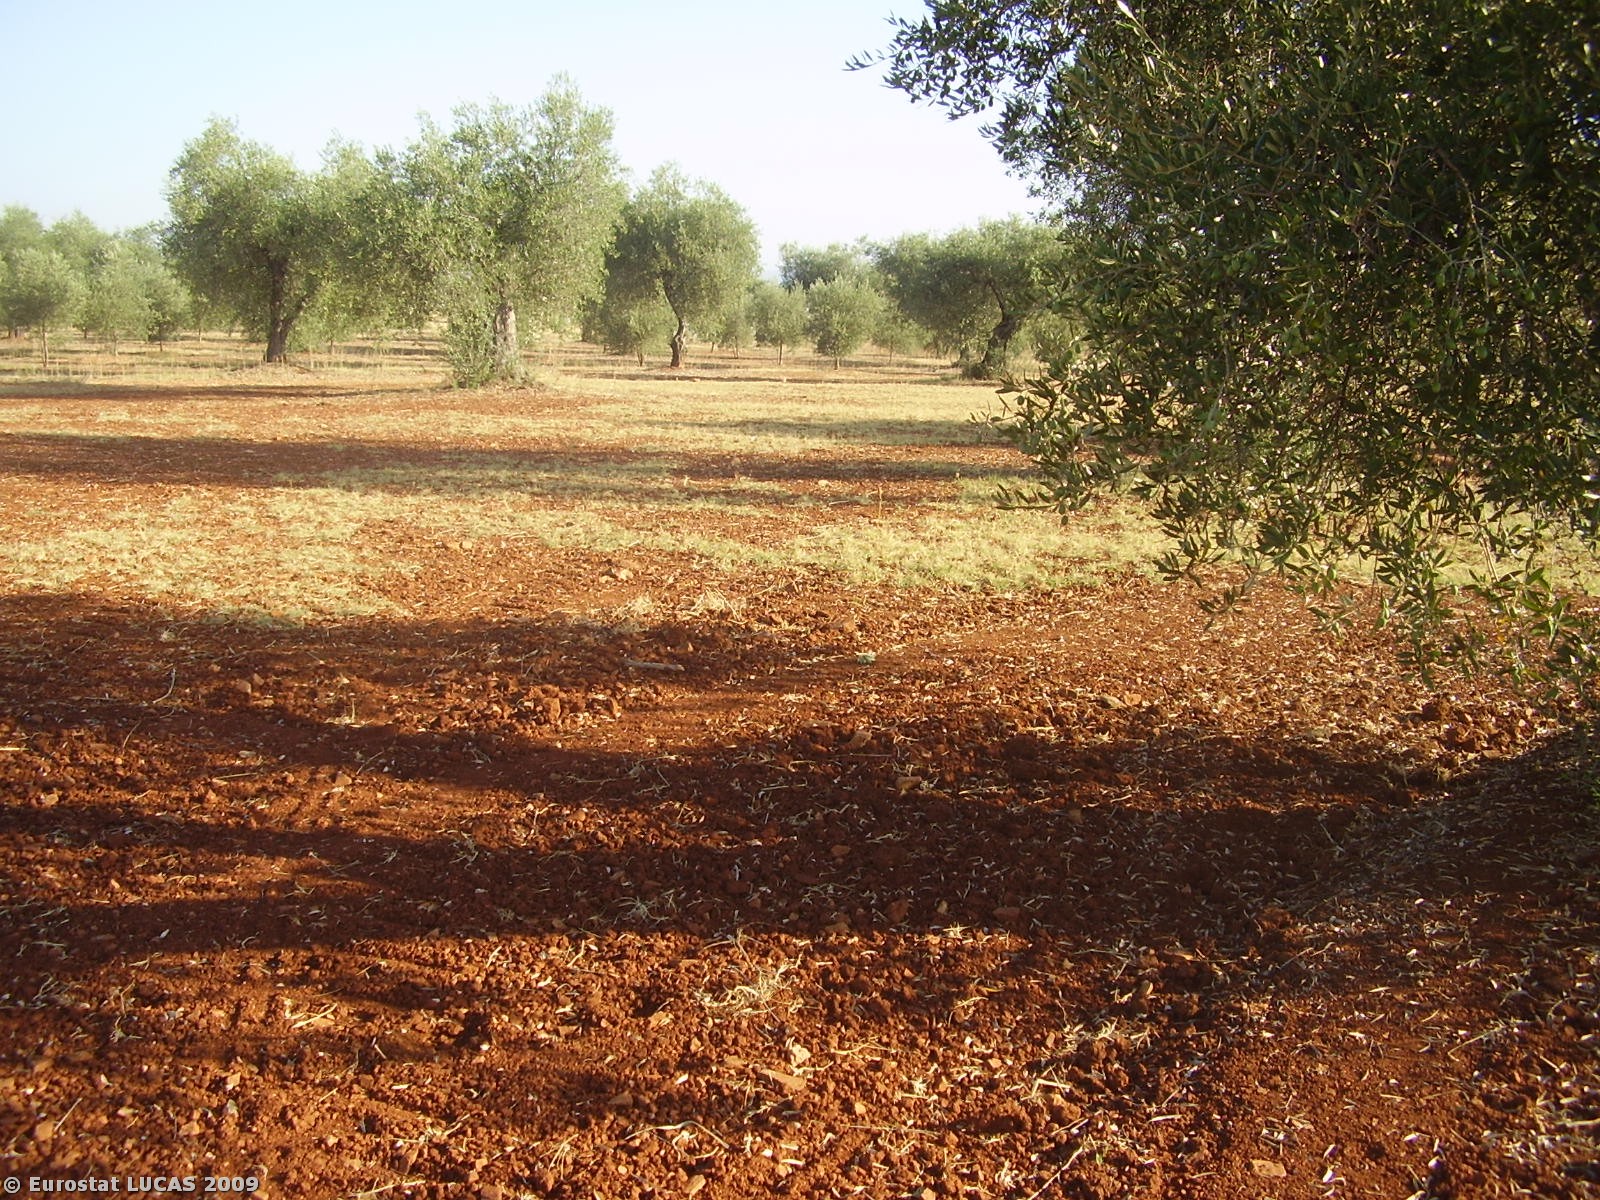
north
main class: Cropland
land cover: Olive groves
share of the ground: 10 - 25 %
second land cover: Spontaneously vegetated surfaces
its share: 50 - 75 %
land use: Agriculture (excluding fallow land and kitchen gardens)
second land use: Fallow land
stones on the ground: 25 - 50 %
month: August
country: PT
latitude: 38.0553
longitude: -7.5841
